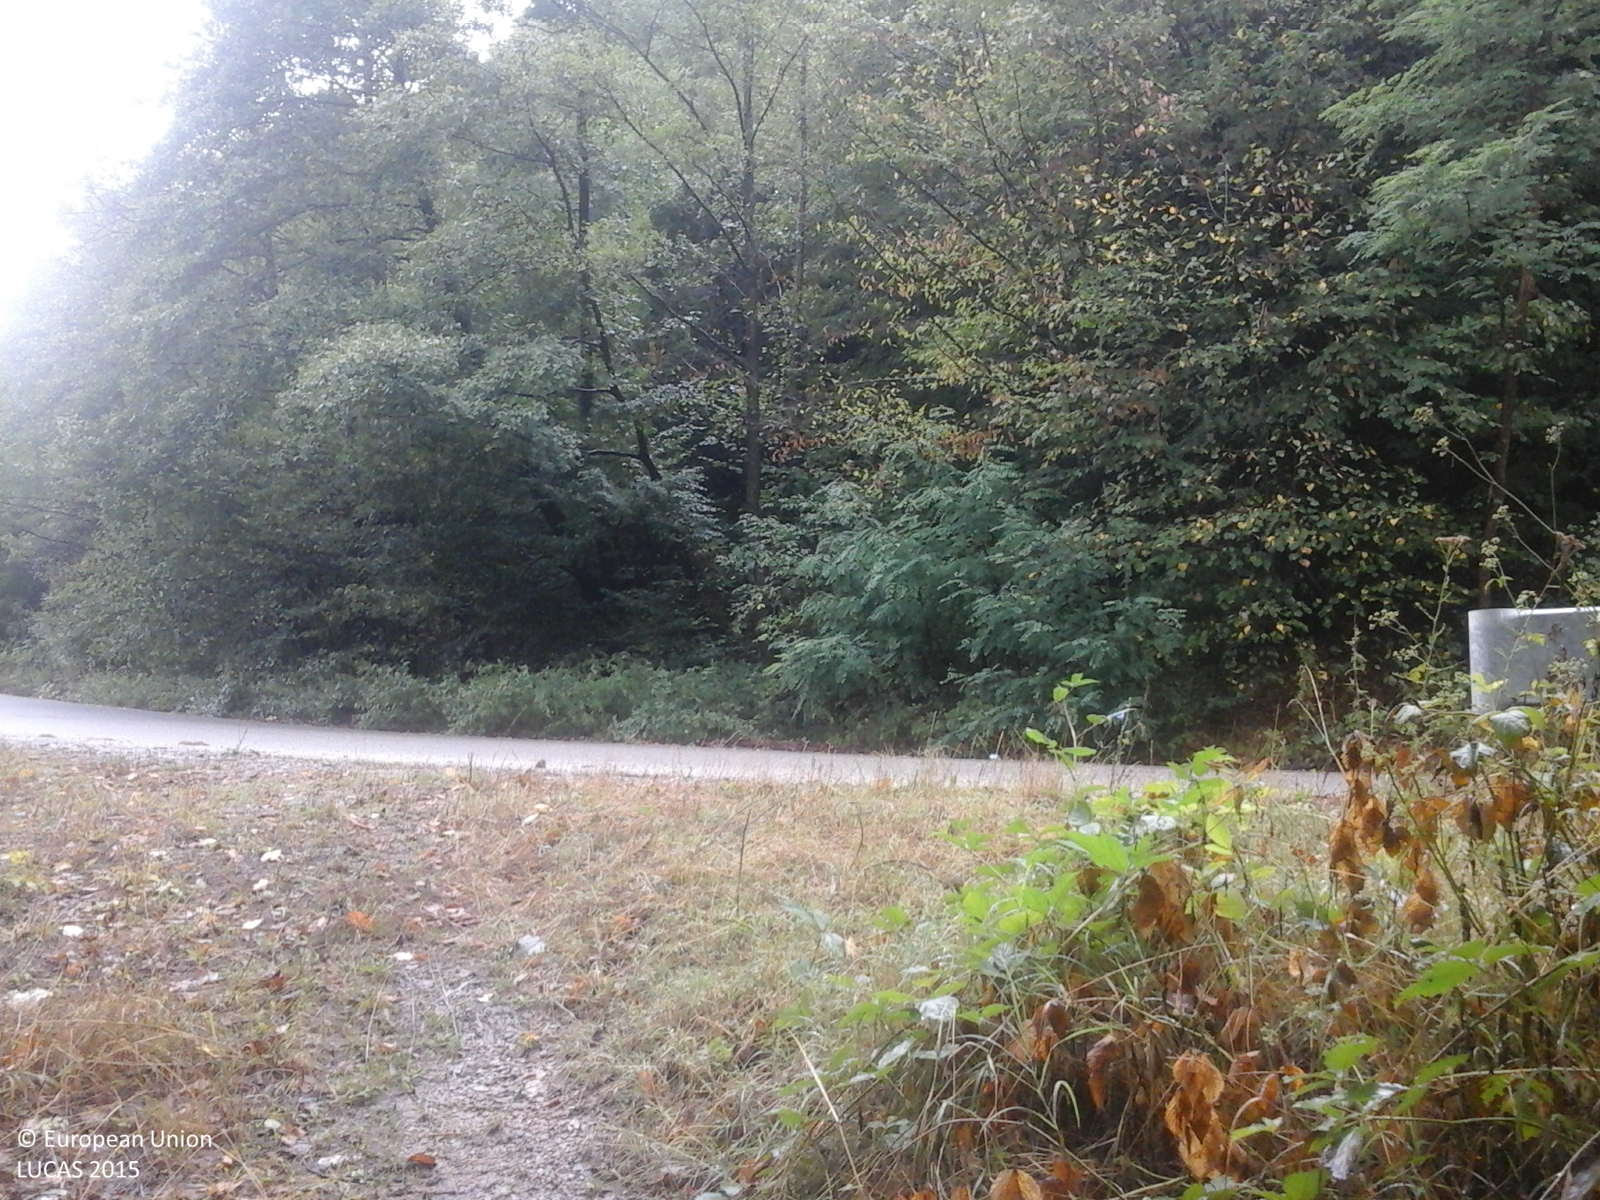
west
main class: Woodland
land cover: Broadleaved woodland
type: mesophytic deciduous forest
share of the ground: > 75 %
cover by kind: broadleaved forest trees 100 %
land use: Forestry
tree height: > 5 m
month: August
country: RO
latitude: 44.9288
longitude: 22.1366
